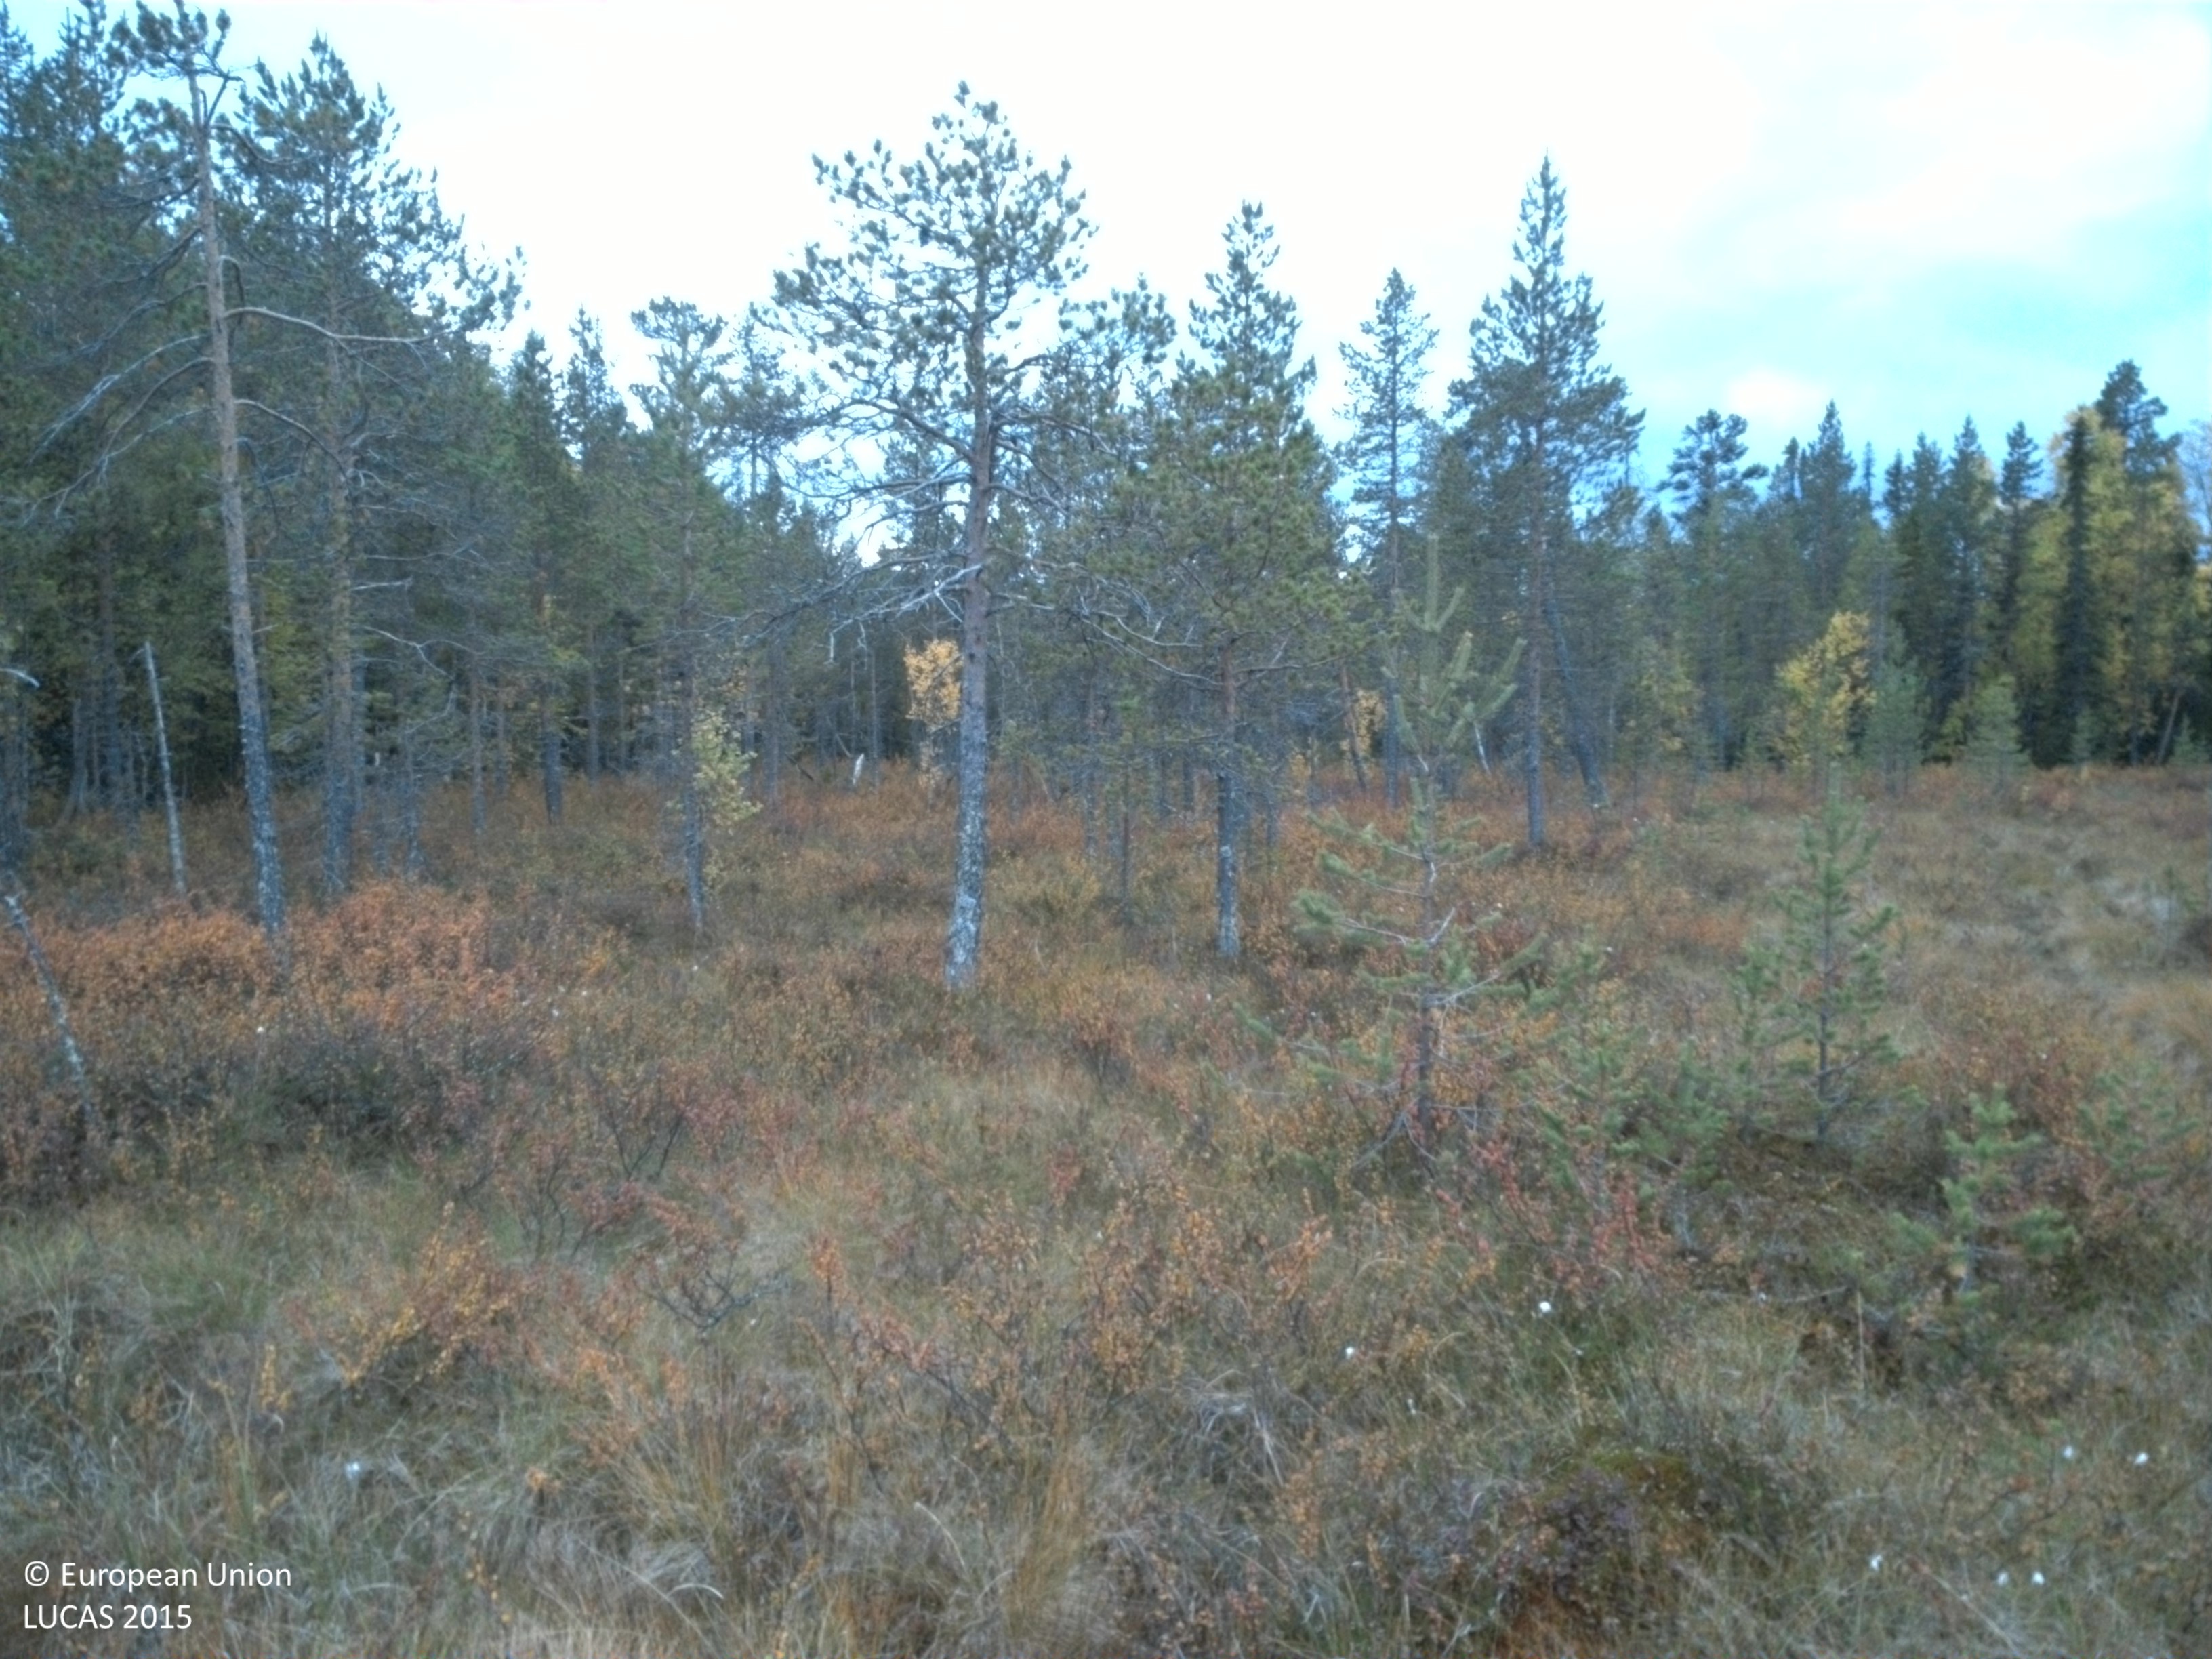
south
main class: Shrubland
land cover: Shrubland with sparse tree cover
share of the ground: 25 - 50 %
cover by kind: herbaceous plants 50 %, shrubs 20 %, lichens and mosses 20 %, coniferous forest trees 5 %, unconsolidated bare surface 5 %
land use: Semi-natural and natural areas not in use
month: September
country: SE
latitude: 65.2020
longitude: 17.0780
